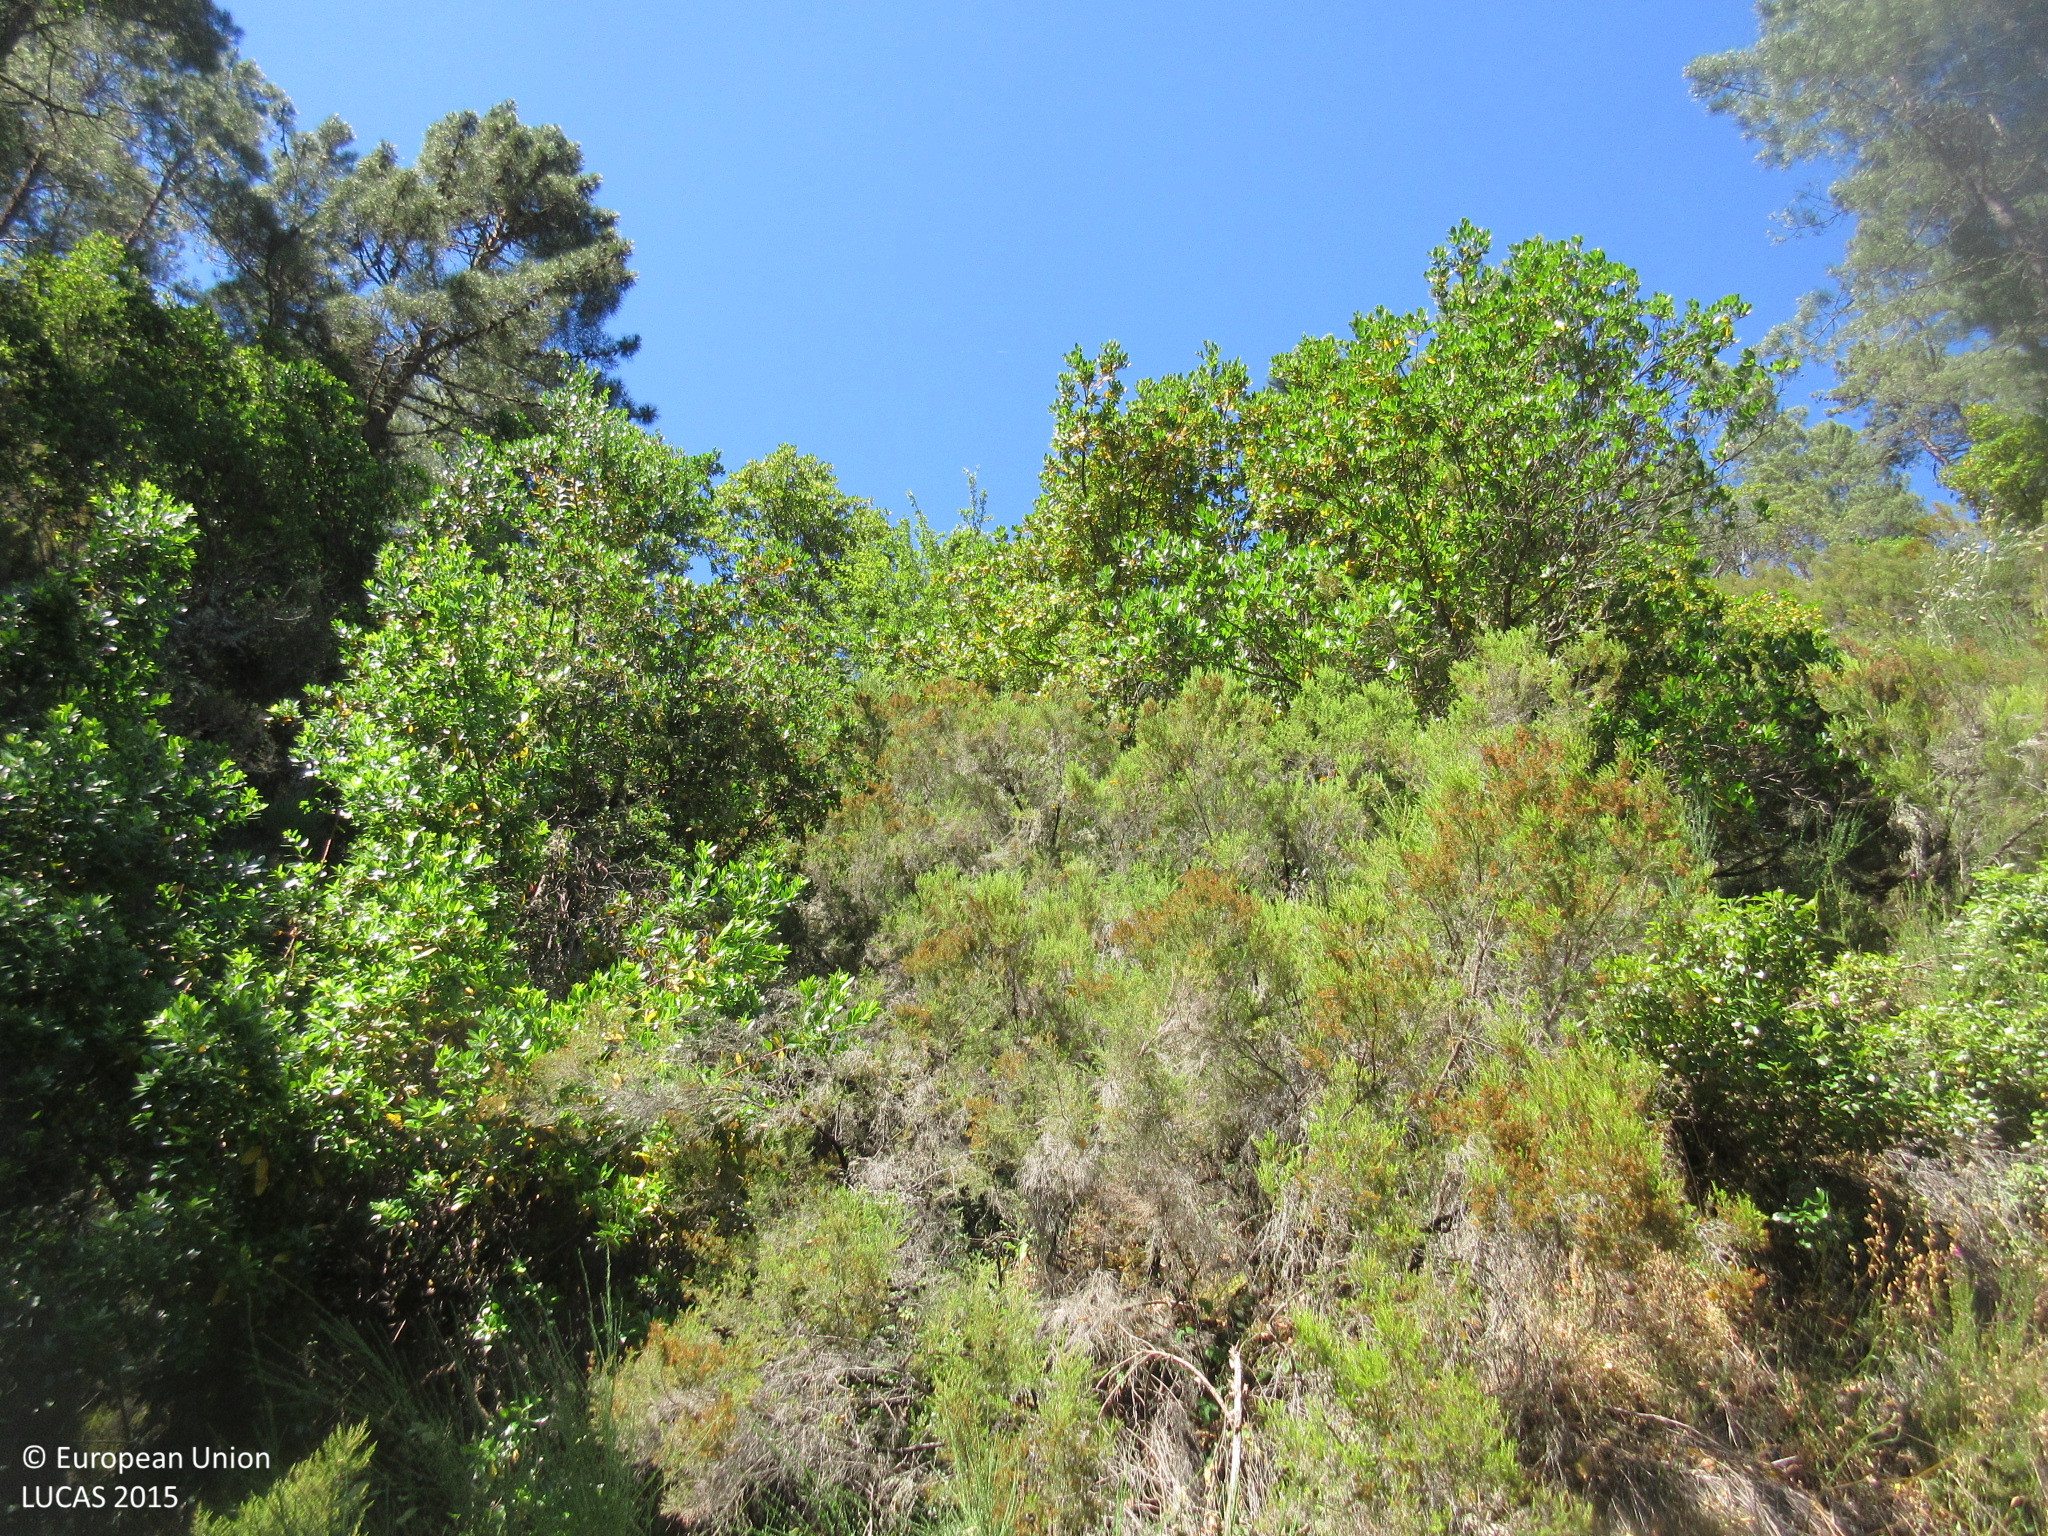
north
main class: Woodland
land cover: Pine dominated coniferous woodland
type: hemiboreal forest and nemoral coniferous forest and mixed broadleaved-coniferous forest
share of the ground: > 75 %
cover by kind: coniferous forest trees 95 %, shrubs 5 %
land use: Forestry
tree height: > 5 m
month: June
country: ES
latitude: 43.0188
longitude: -6.8317
